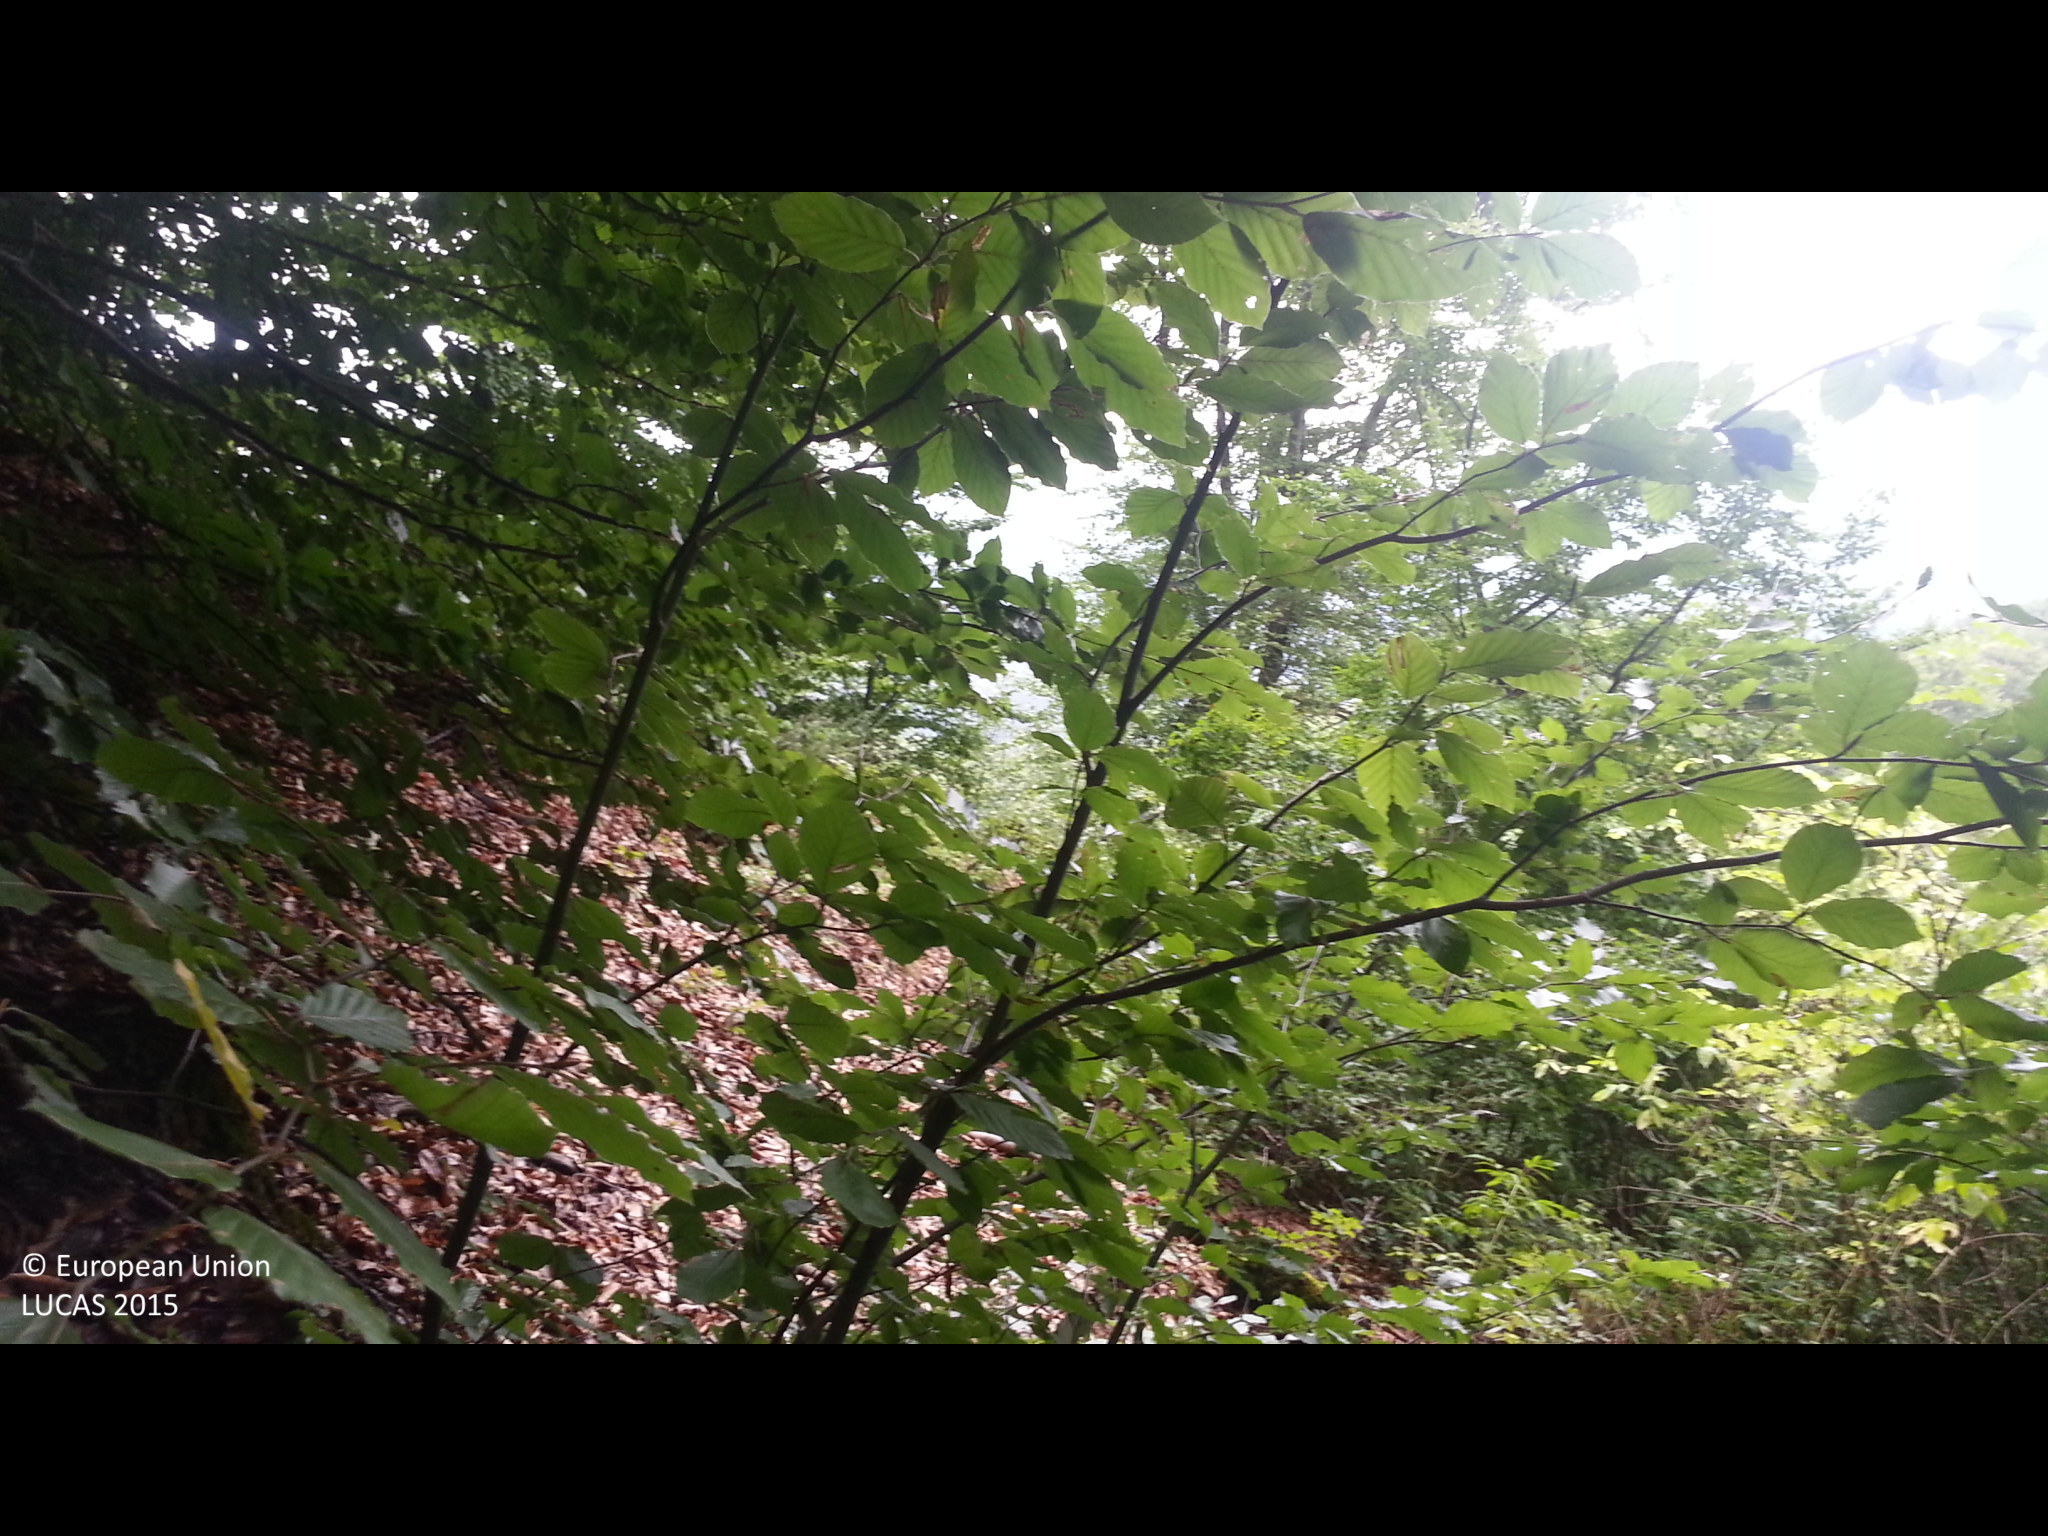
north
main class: Woodland
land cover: Broadleaved woodland
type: mountainous beech forest
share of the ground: > 75 %
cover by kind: broadleaved forest trees 95 %, shrubs 5 %
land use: Forestry
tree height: > 5 m
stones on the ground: < 10 %
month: September
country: BG
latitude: 42.3998
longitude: 22.5468
